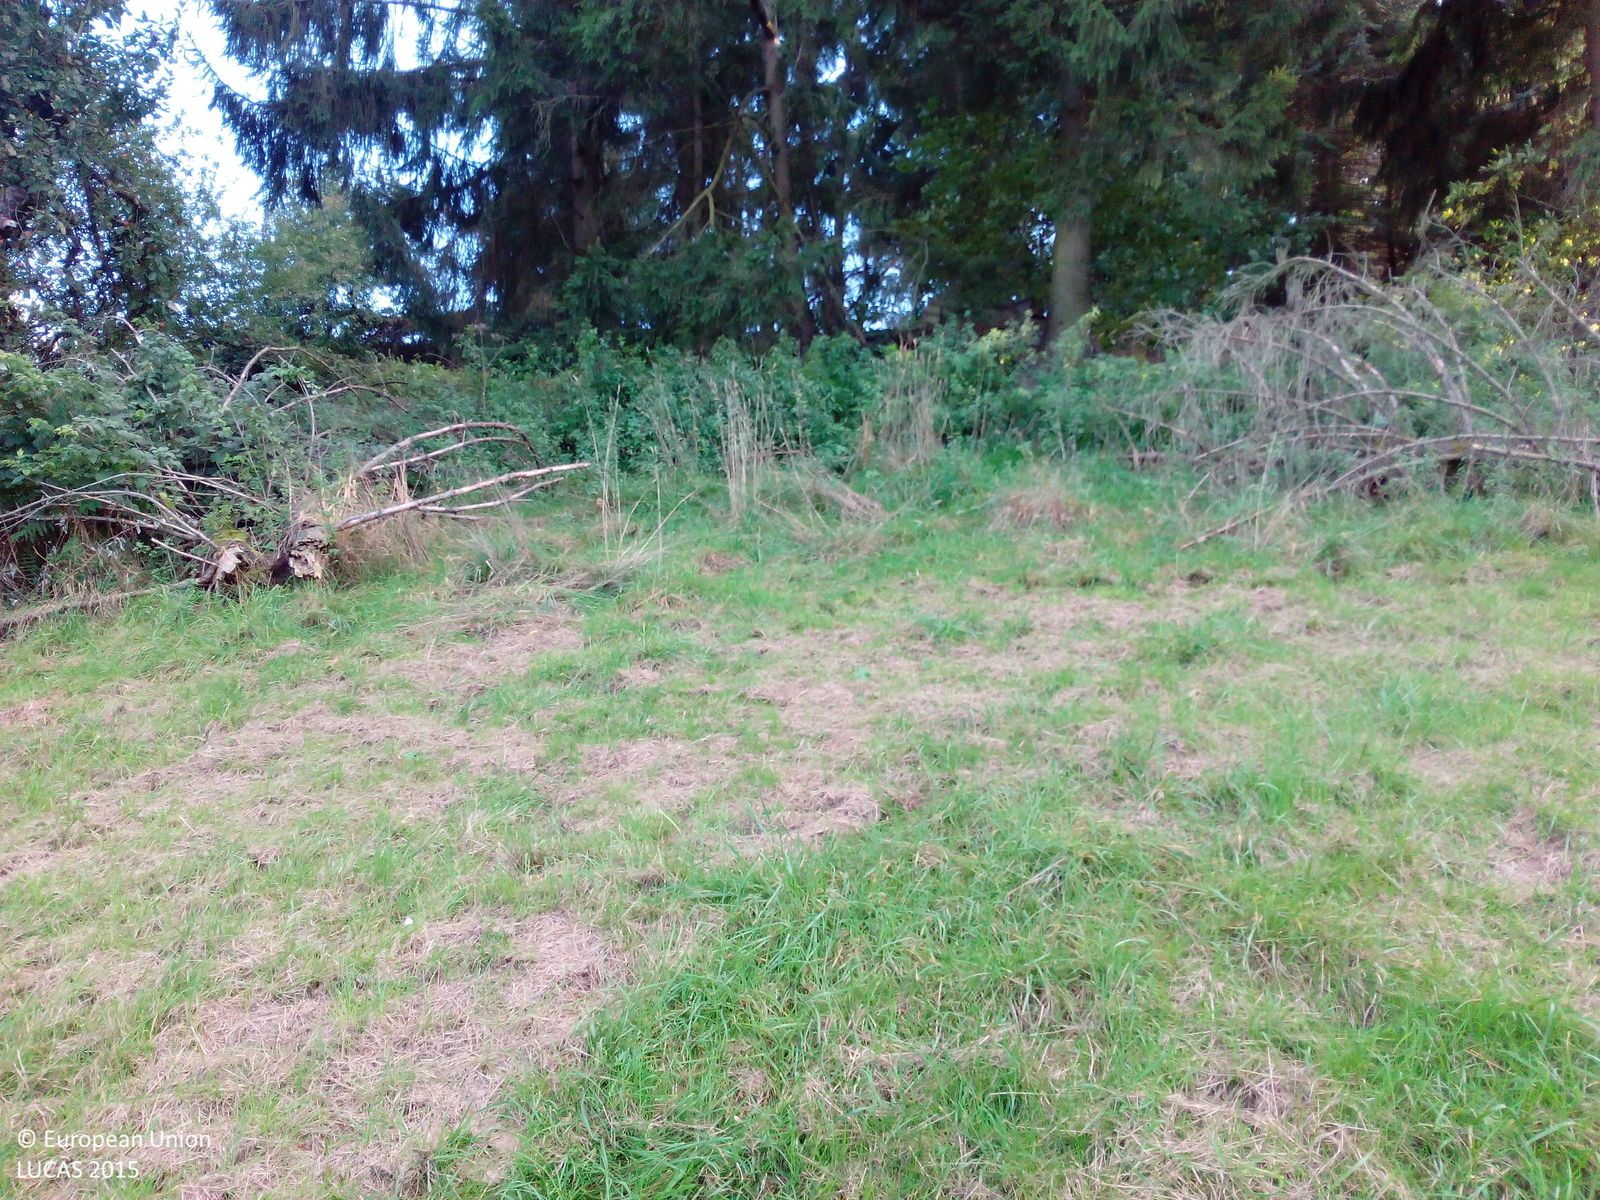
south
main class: Grassland
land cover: Grassland with sparse tree/shrub cover
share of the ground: > 75 %
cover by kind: herbaceous plants 95 %, broadleaved forest trees 5 %
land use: Agriculture (excluding fallow land and kitchen gardens)
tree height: > 5 m
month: September
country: DE
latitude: 50.2361
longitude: 9.3132
